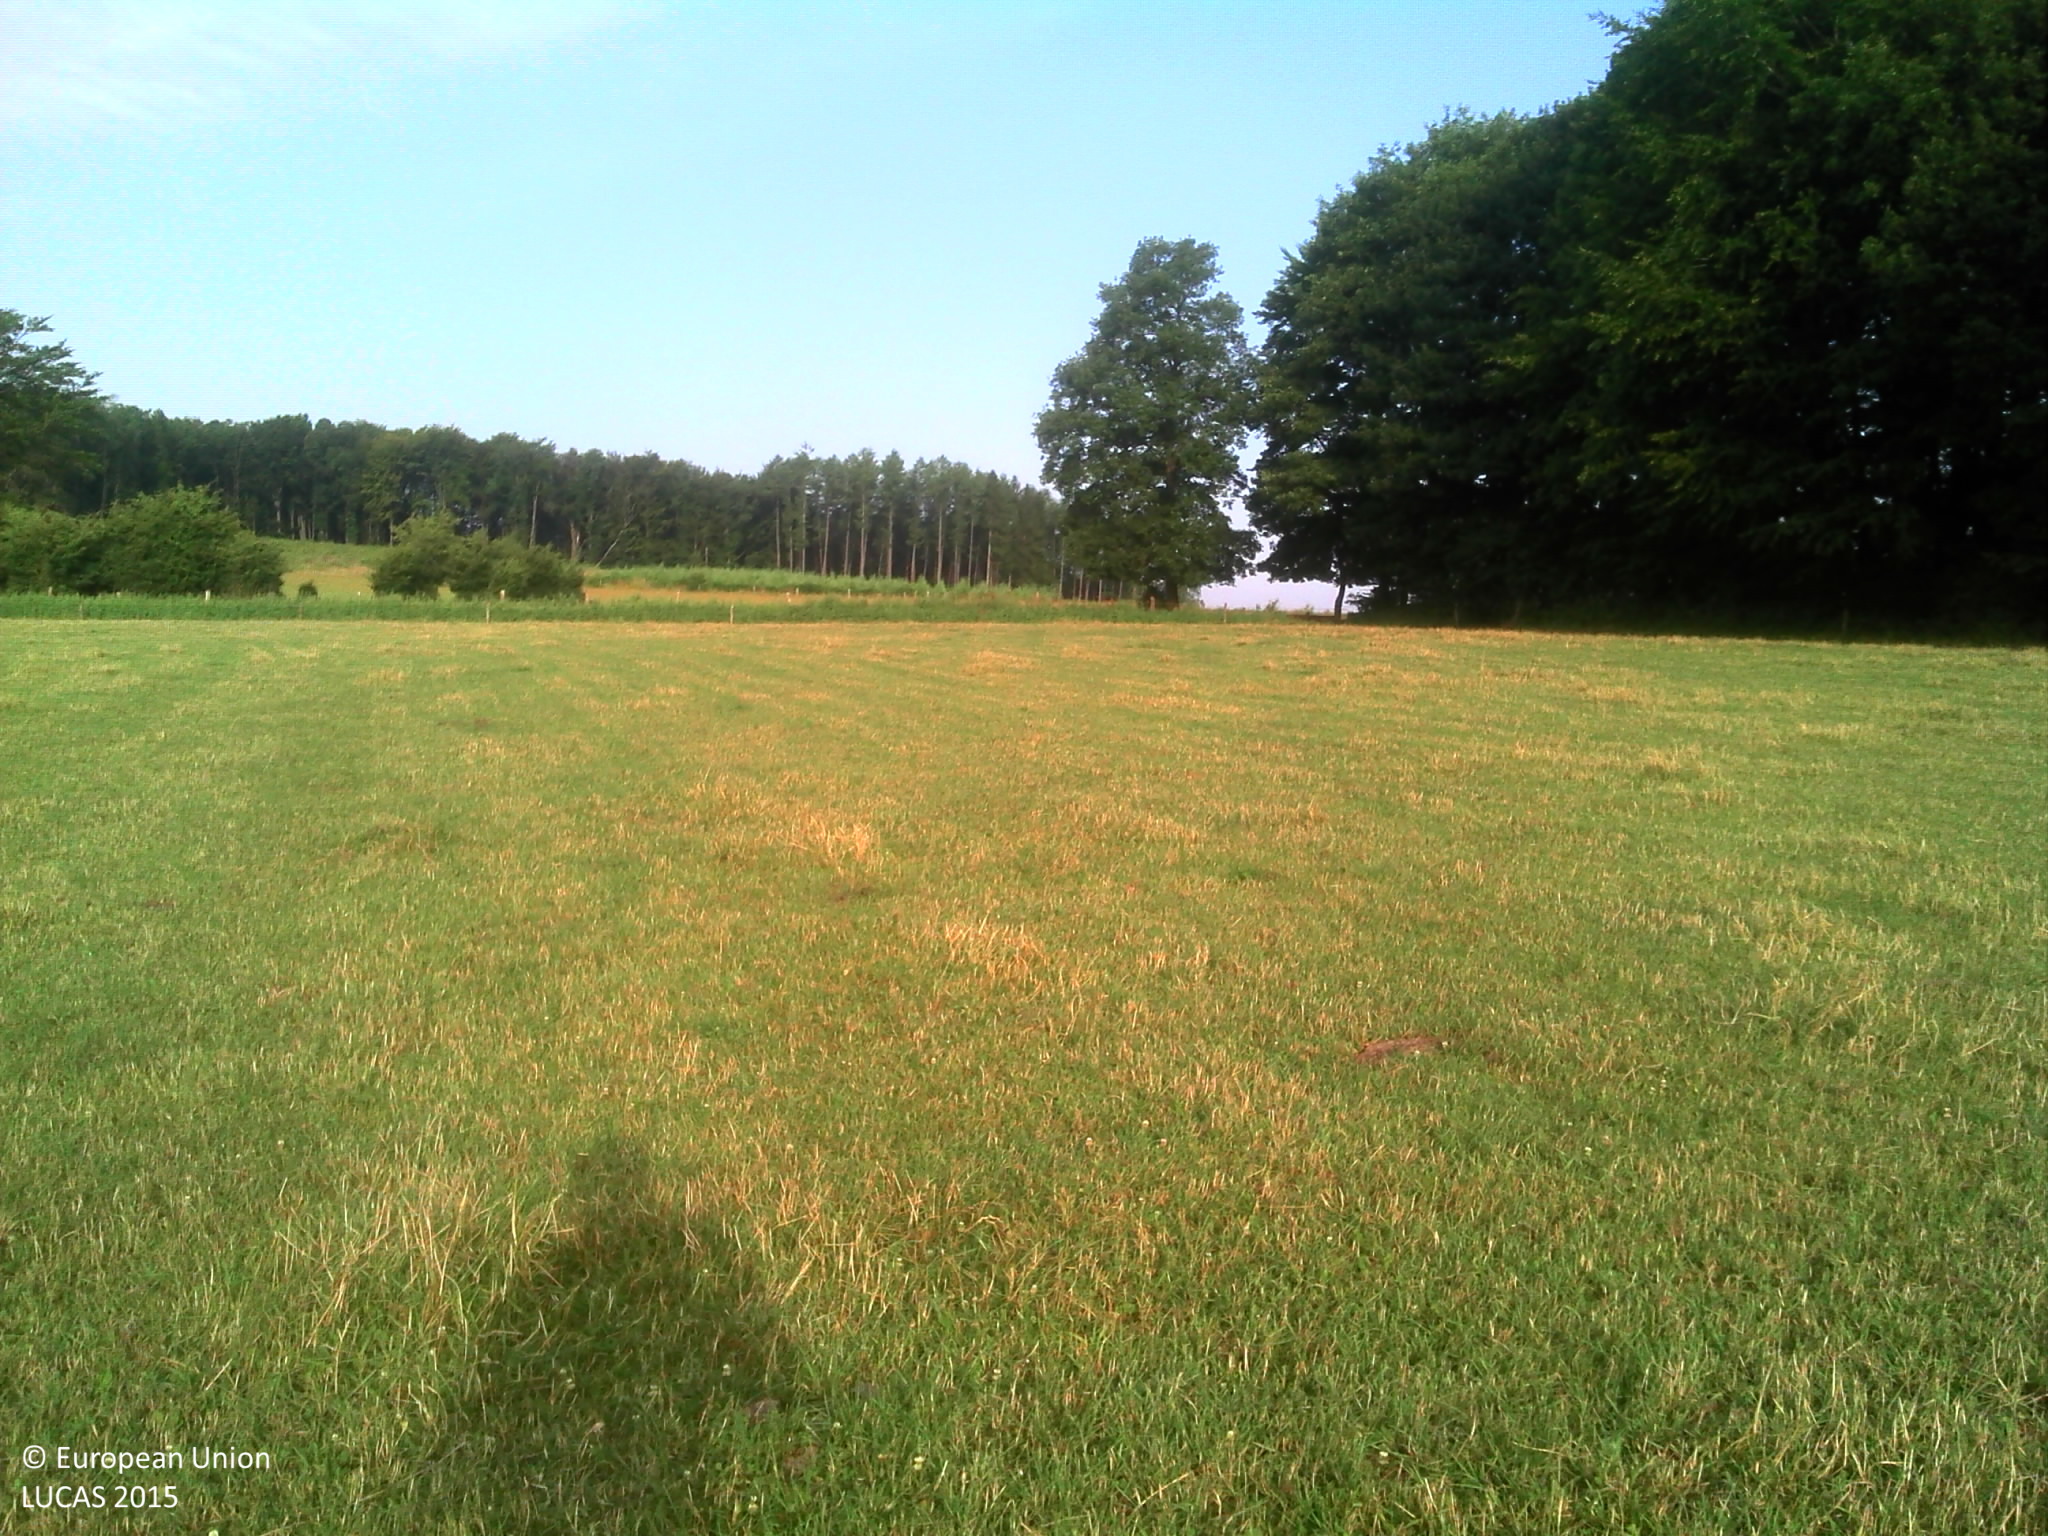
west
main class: Grassland
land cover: Grassland without tree/shrub cover
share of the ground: > 75 %
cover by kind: herbaceous plants 100 %
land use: Agriculture (excluding fallow land and kitchen gardens)
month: July
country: BE
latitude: 49.9398
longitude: 5.6653
